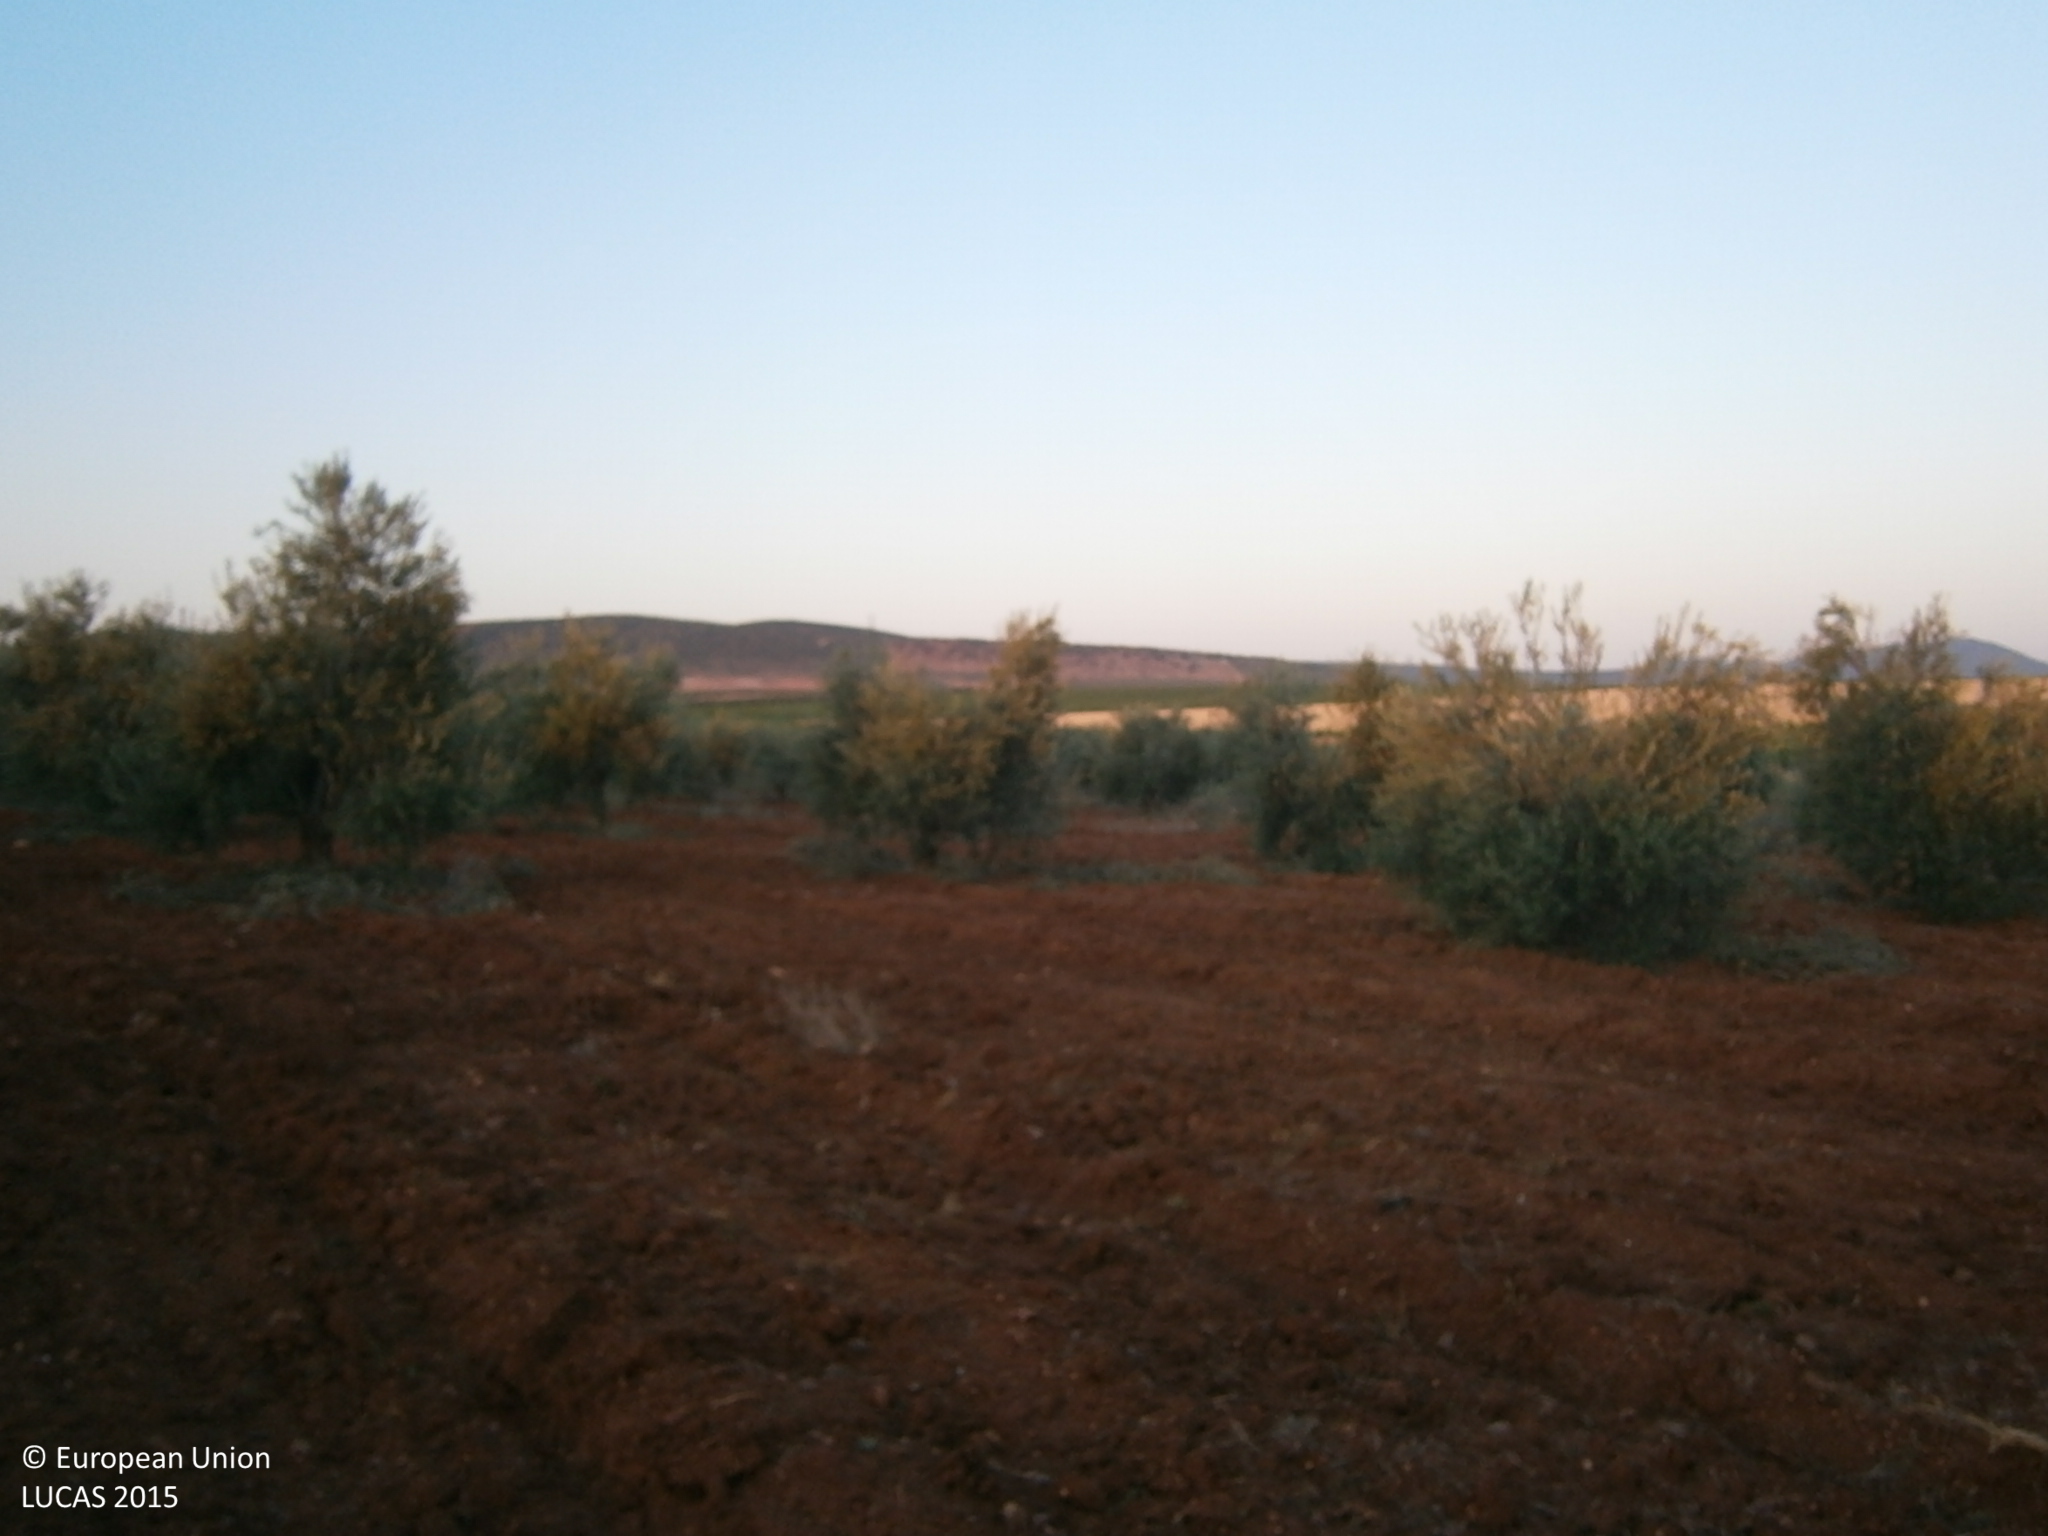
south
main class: Cropland
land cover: Olive groves
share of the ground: 25 - 50 %
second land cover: Other bare soil
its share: > 75 %
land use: Agriculture (excluding fallow land and kitchen gardens)
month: June
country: ES
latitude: 38.6253
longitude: -6.6799
